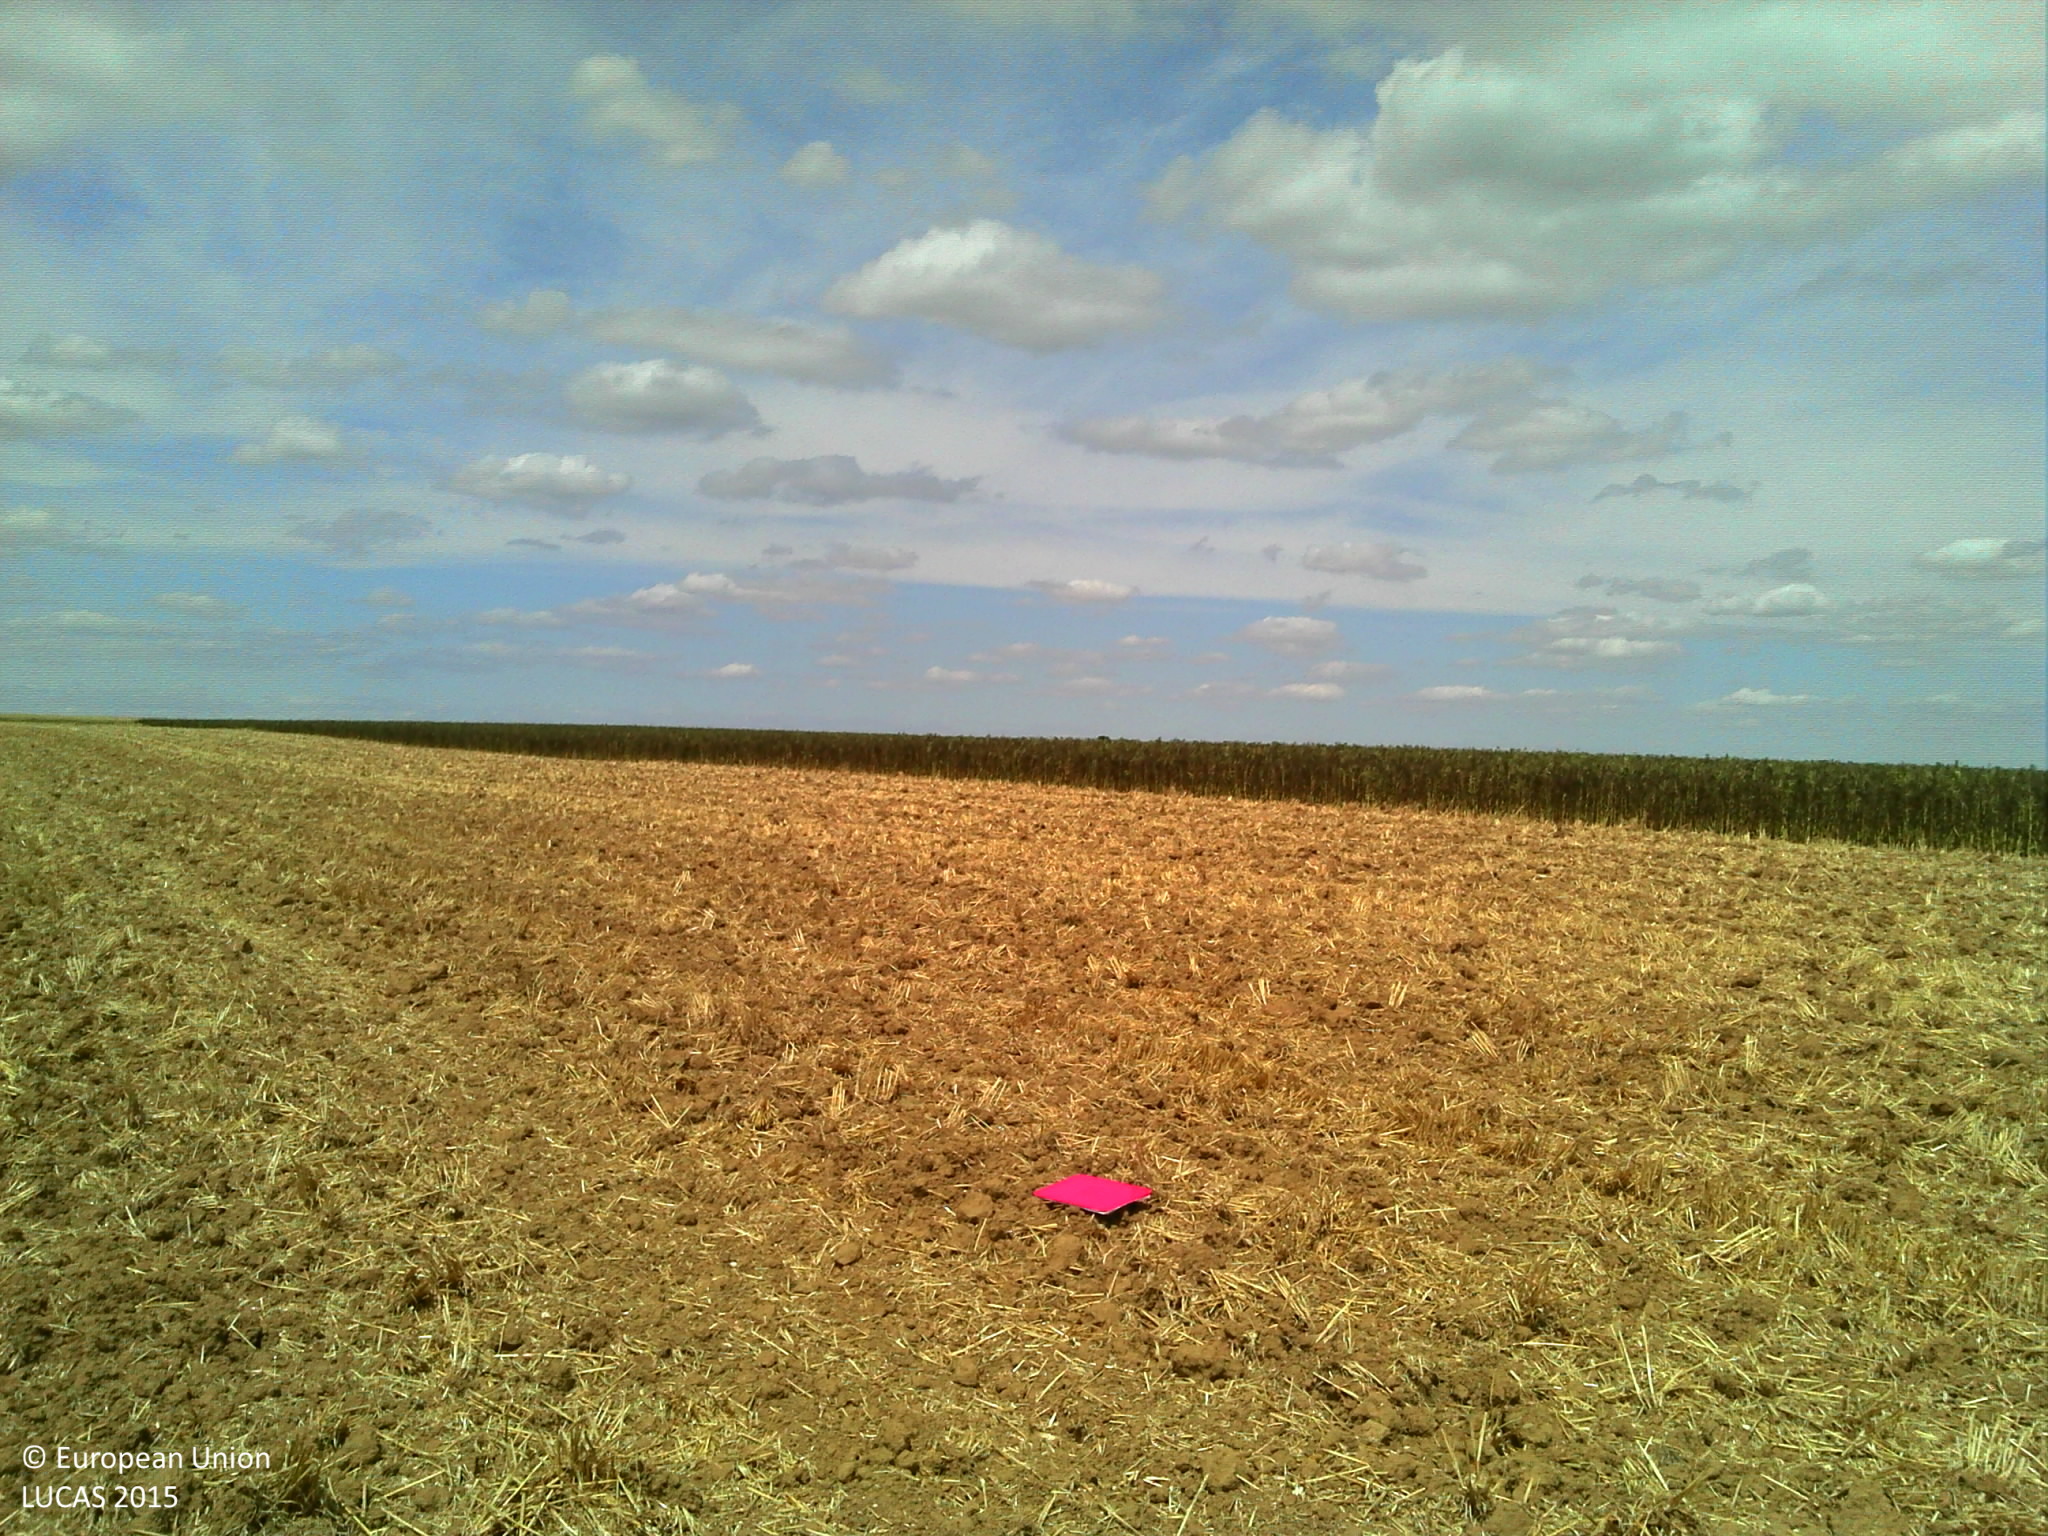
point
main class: Cropland
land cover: Barley
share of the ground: > 75 %
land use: Agriculture (excluding fallow land and kitchen gardens)
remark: Harvested field
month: July
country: FR
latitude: 49.0951
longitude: 2.8827
